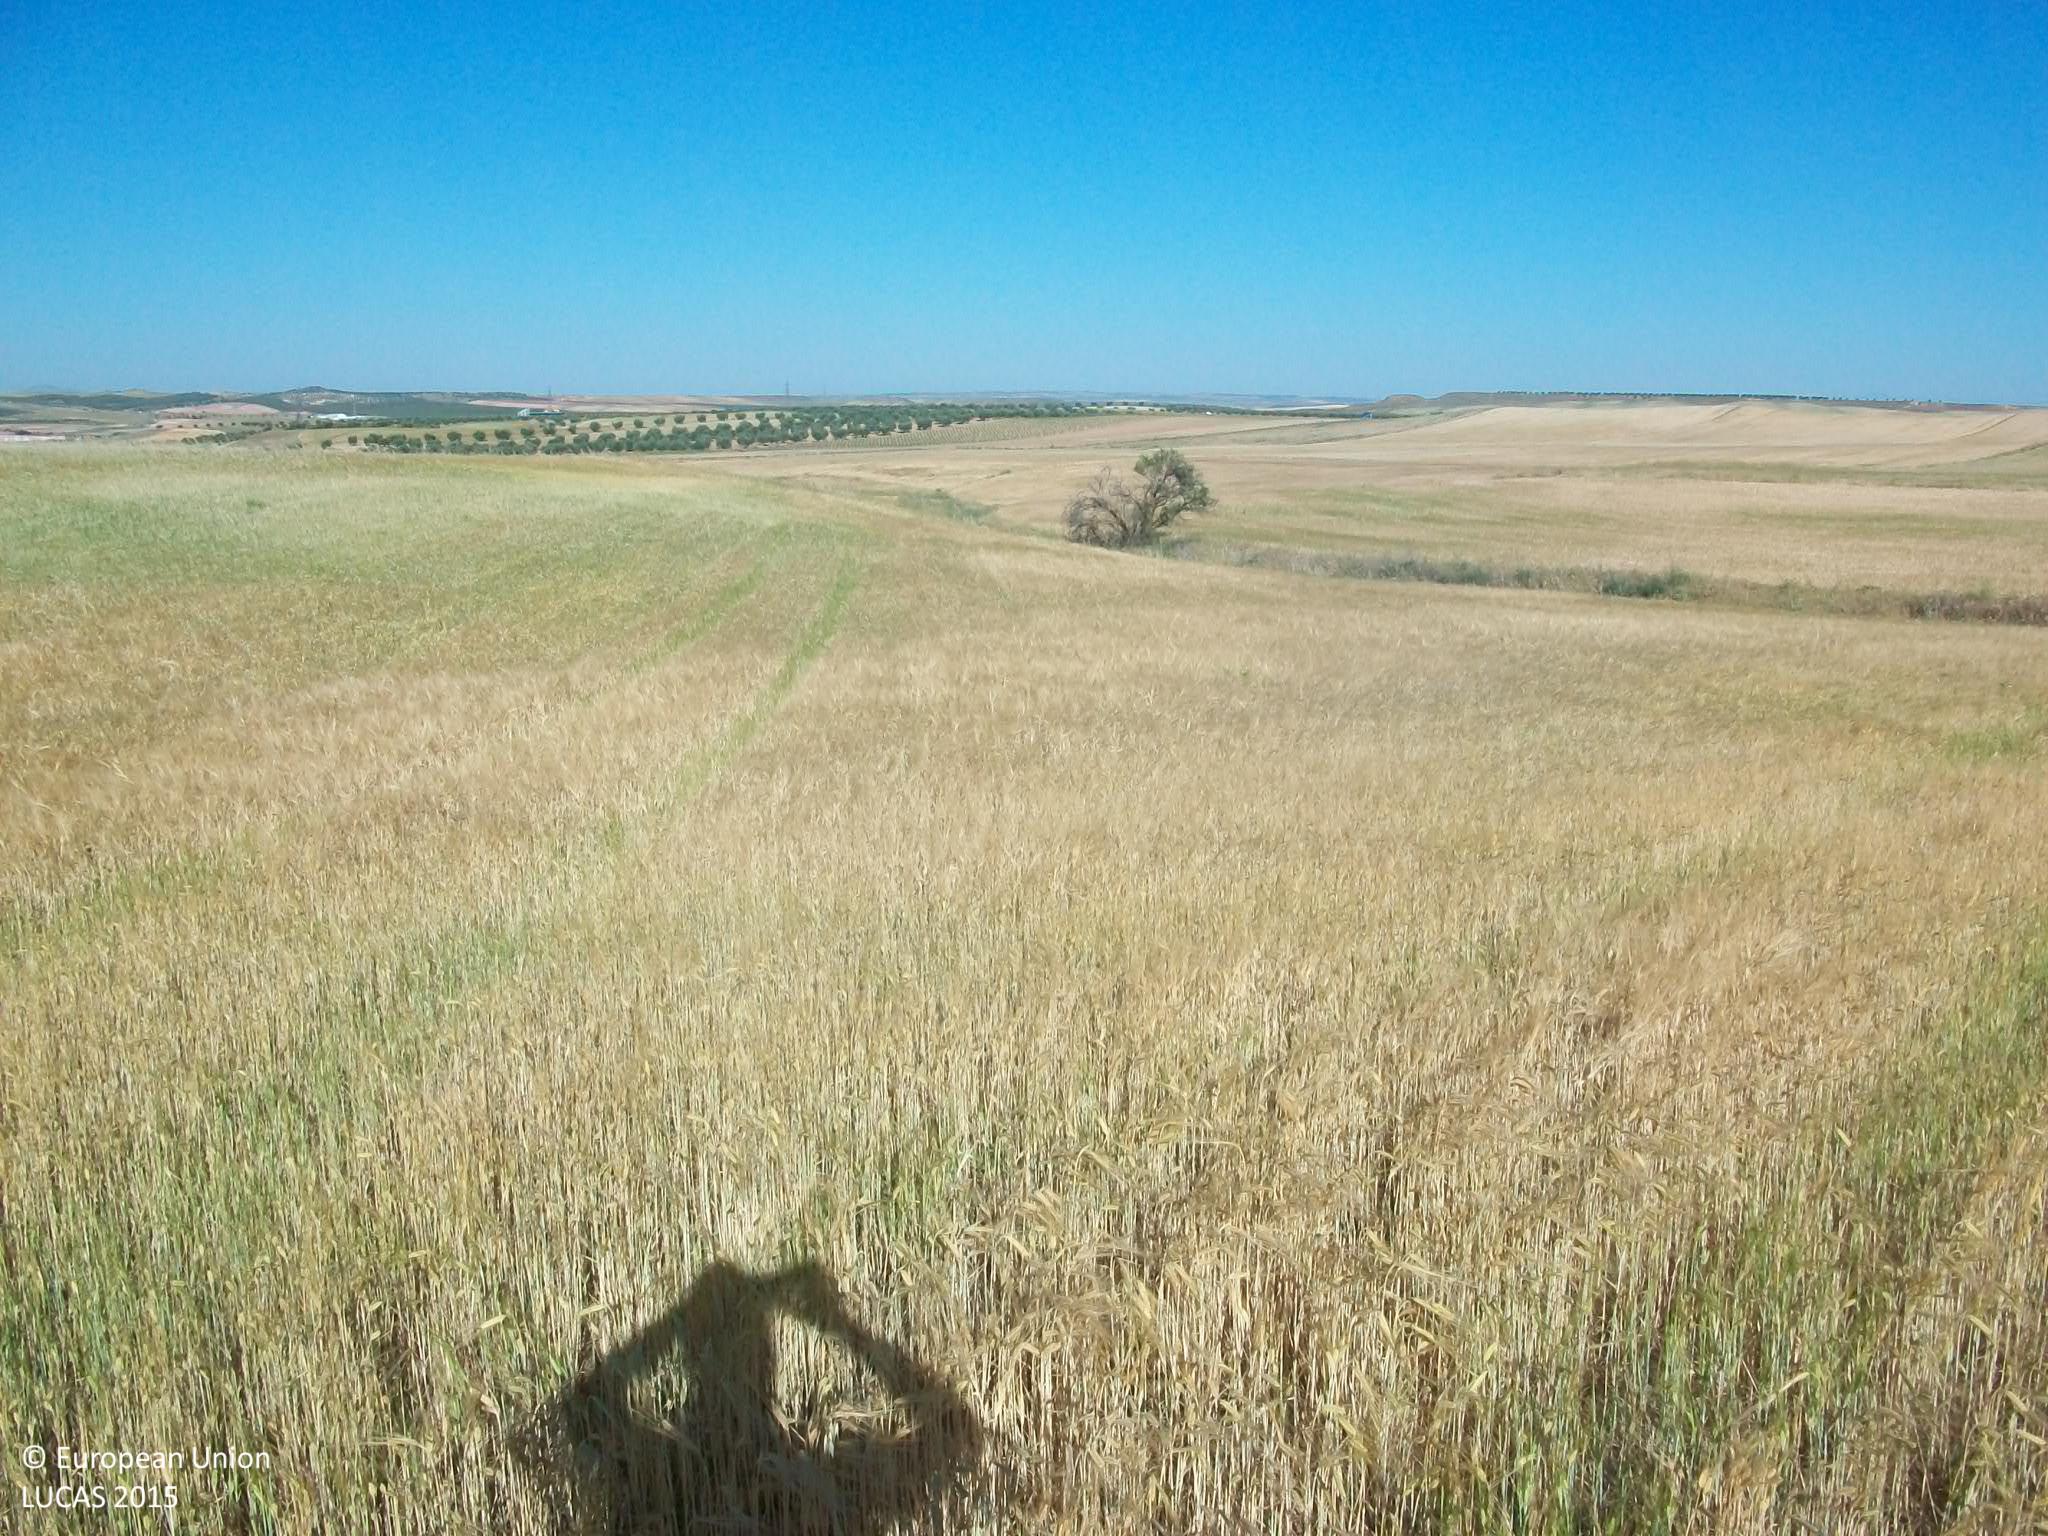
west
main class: Cropland
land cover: Barley
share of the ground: > 75 %
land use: Agriculture (excluding fallow land and kitchen gardens)
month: May
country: ES
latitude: 39.9020
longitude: -3.7277
